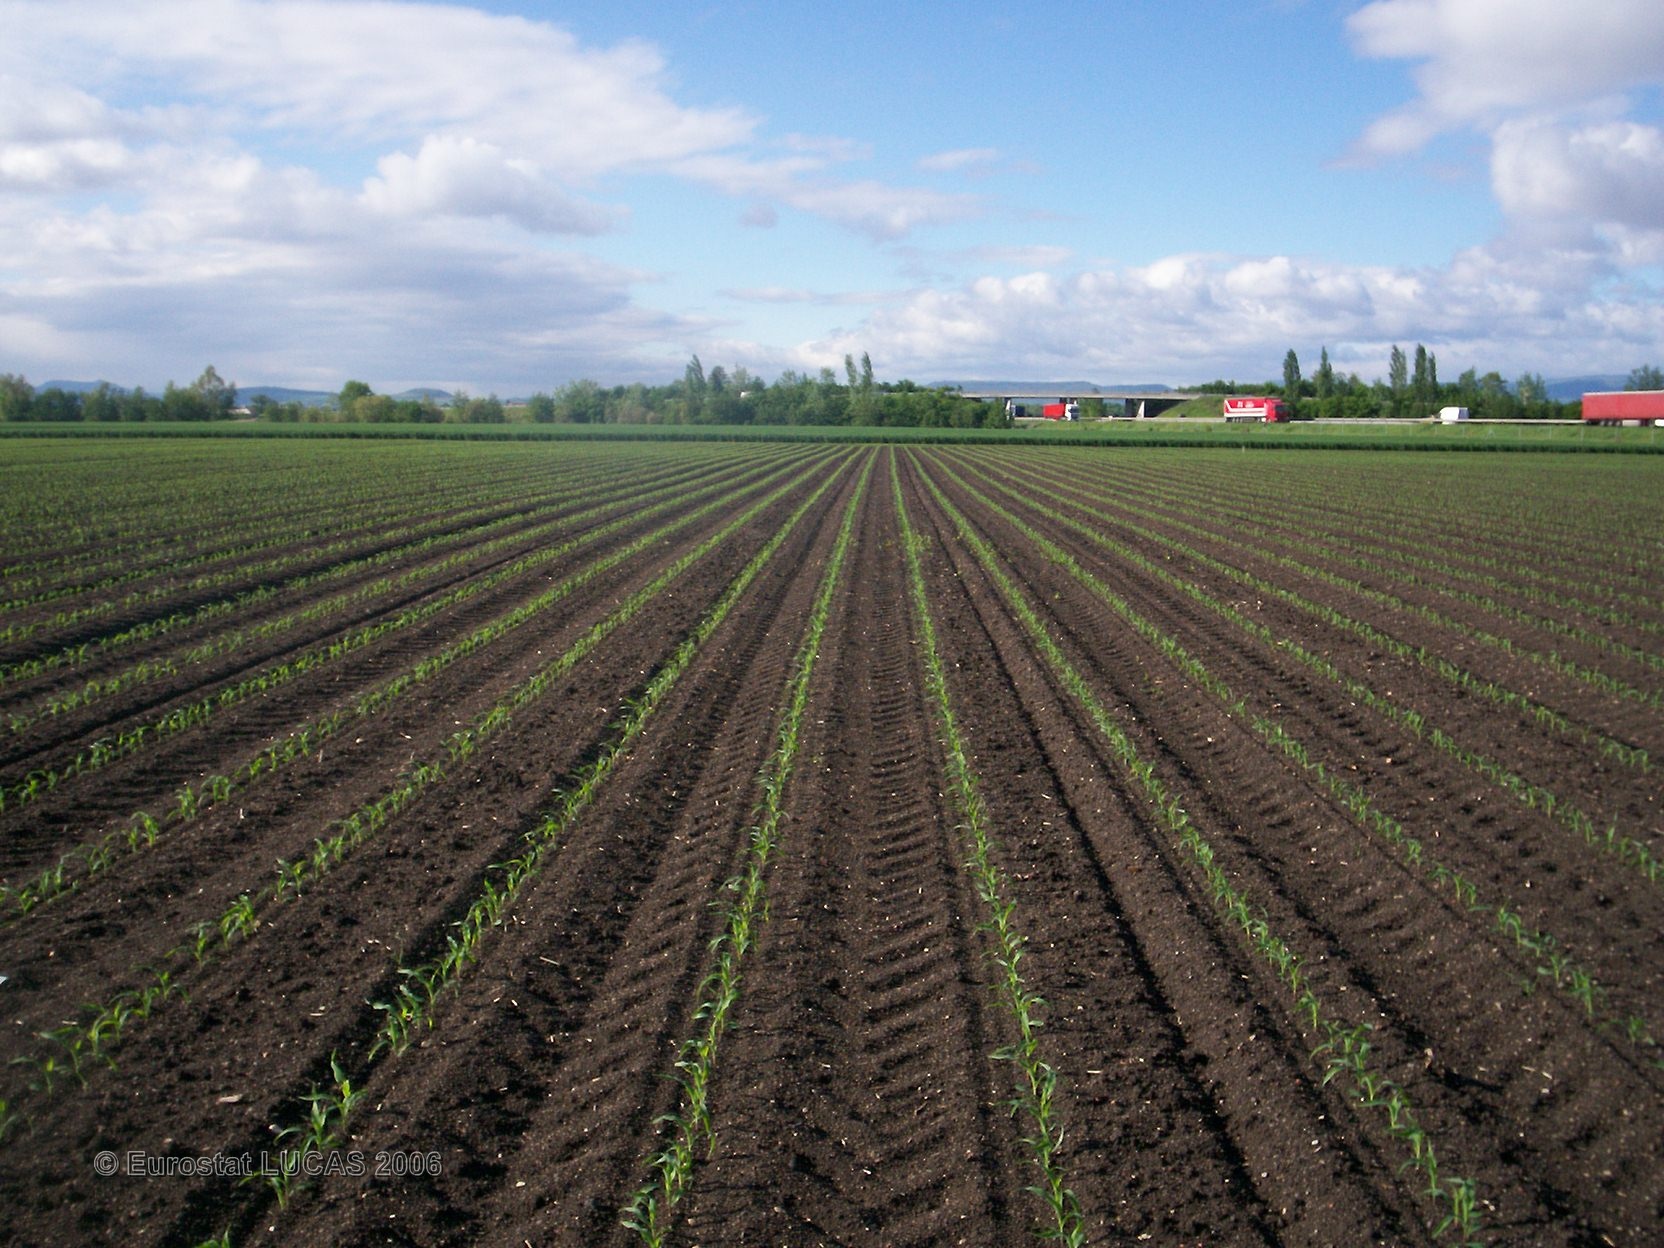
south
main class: Cropland
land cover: Maize
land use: Agriculture (excluding fallow land and kitchen gardens)
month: May
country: FR
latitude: 45.8610
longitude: 3.1603
